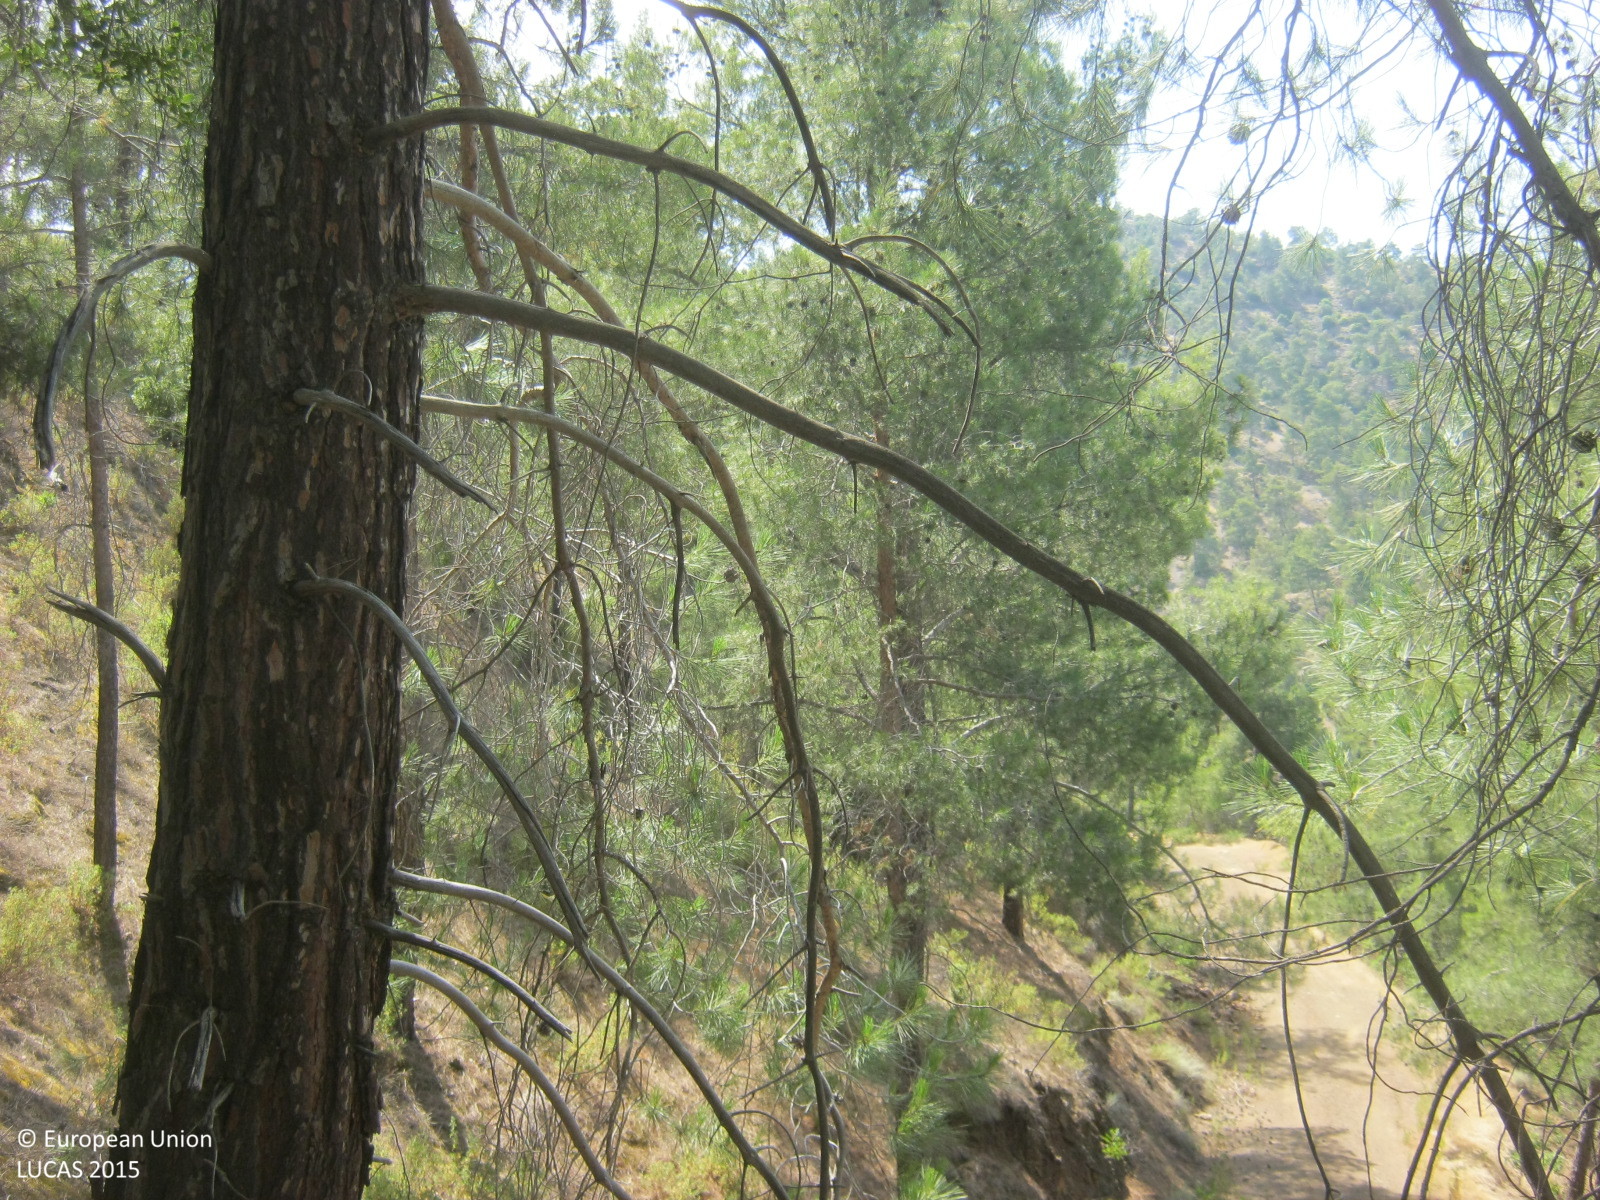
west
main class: Woodland
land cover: Pine dominated coniferous woodland
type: coniferous forest of the mediterranean region
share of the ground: > 75 %
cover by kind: coniferous forest trees 85 %, shrubs 10 %, unconsolidated bare surface 5 %
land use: Forestry
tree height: > 5 m
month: June
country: CY
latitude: 35.0022
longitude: 33.0658
